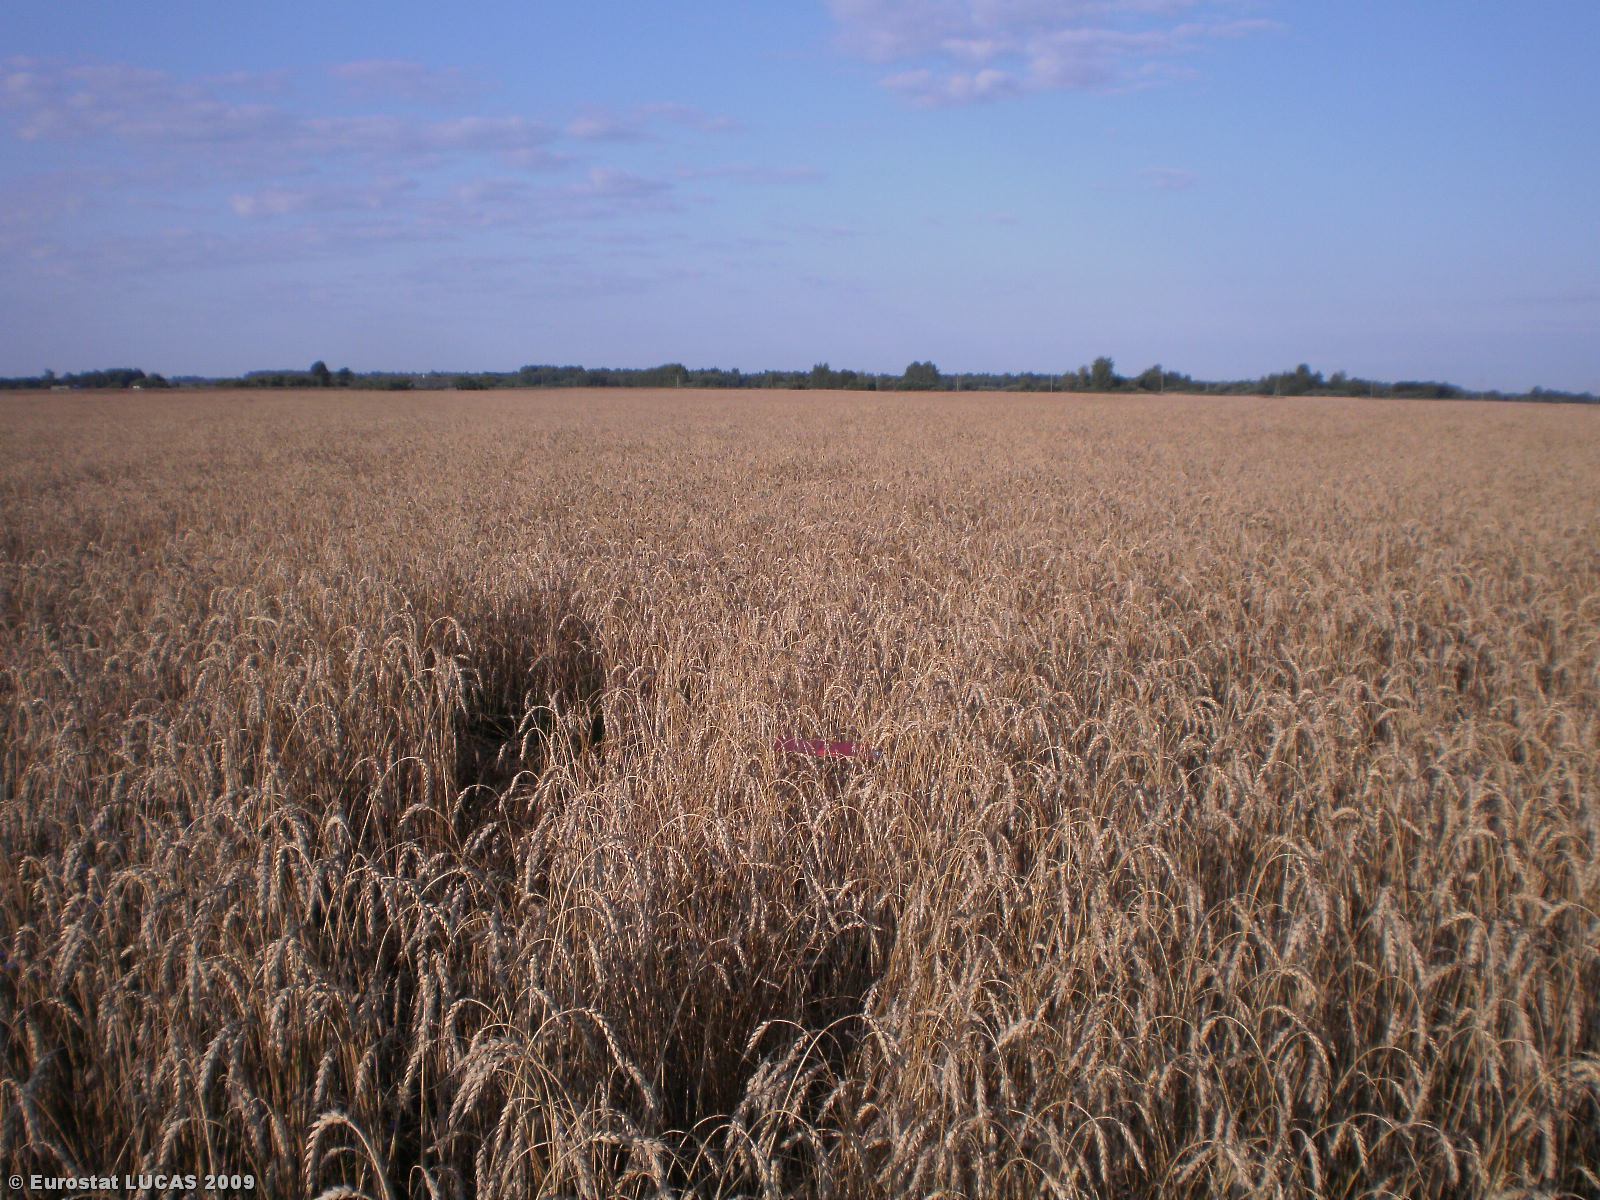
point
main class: Cropland
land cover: Common wheat
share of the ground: > 75 %
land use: Agriculture (excluding fallow land and kitchen gardens)
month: August
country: LT
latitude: 55.5040
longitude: 24.8156
